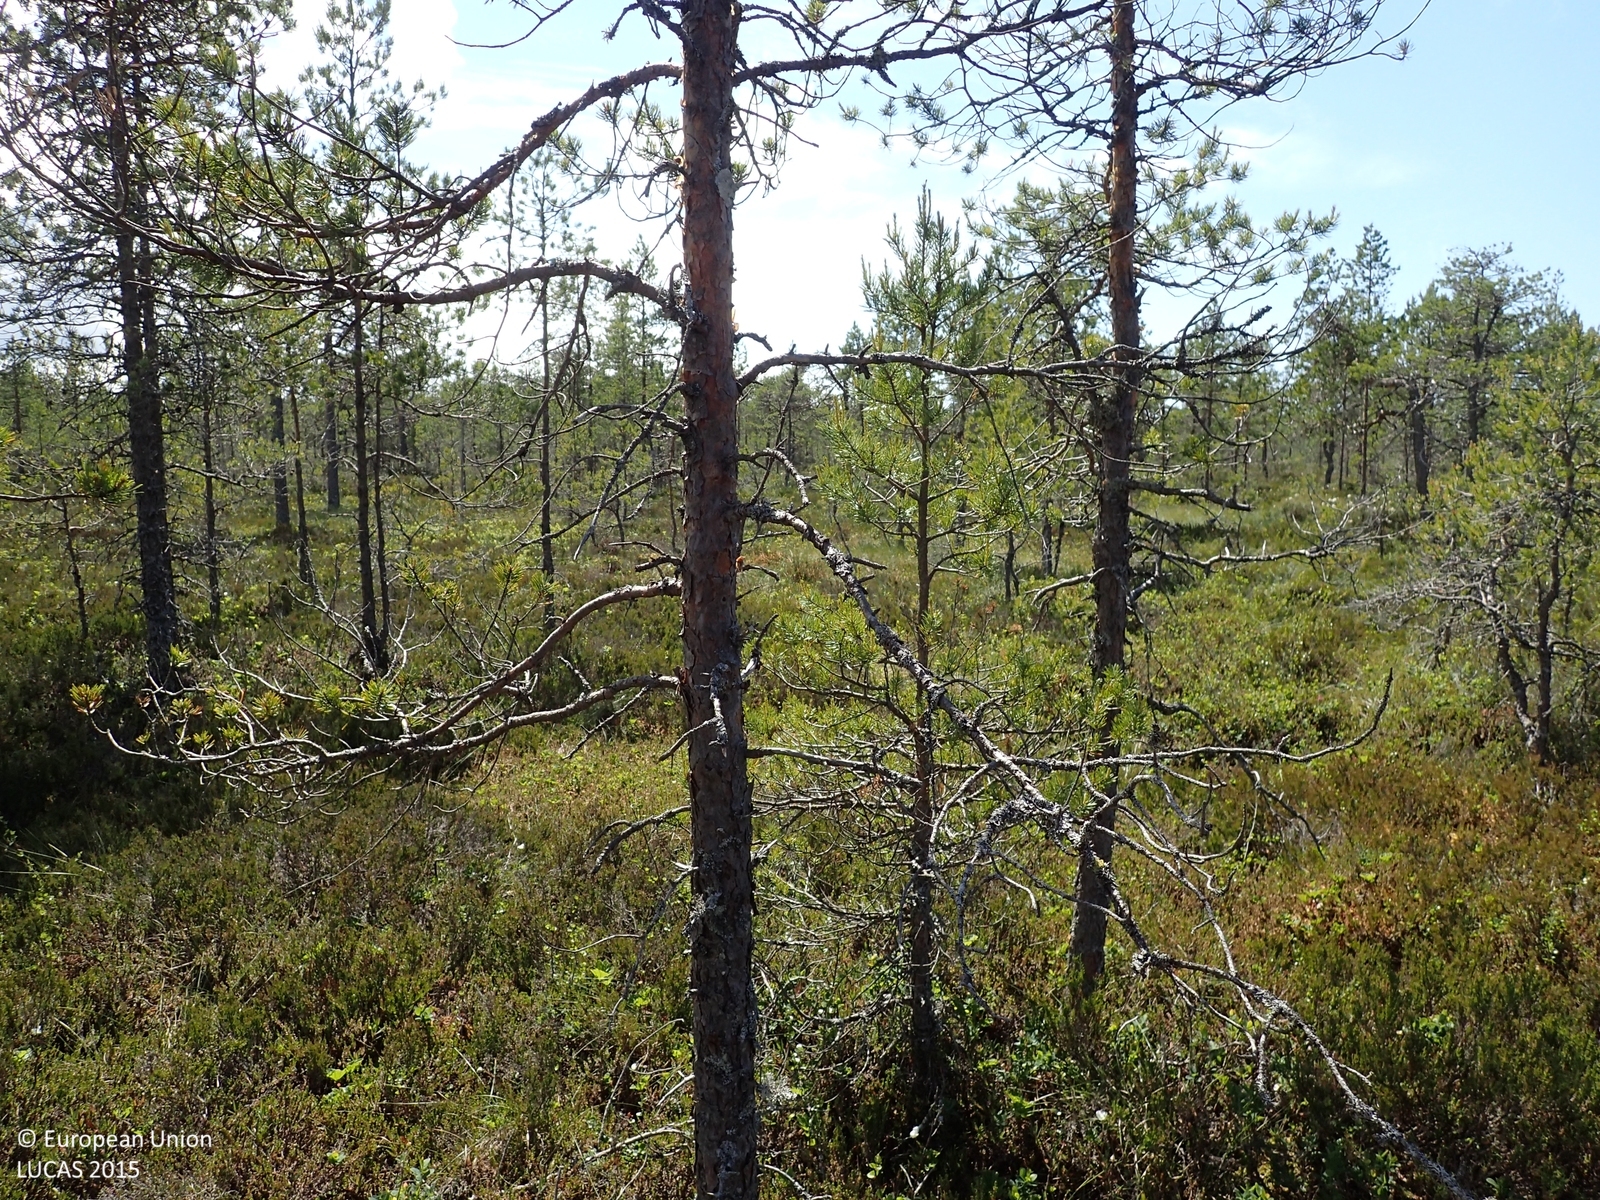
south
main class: Woodland
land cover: Pine dominated coniferous woodland
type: mire and swamp forests
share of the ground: 10 - 25 %
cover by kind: shrubs 80 %, coniferous forest trees 15 %, lichens and mosses 5 %
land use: Semi-natural and natural areas not in use
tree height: < 5 m
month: June
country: FI
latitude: 62.3913
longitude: 21.4751
